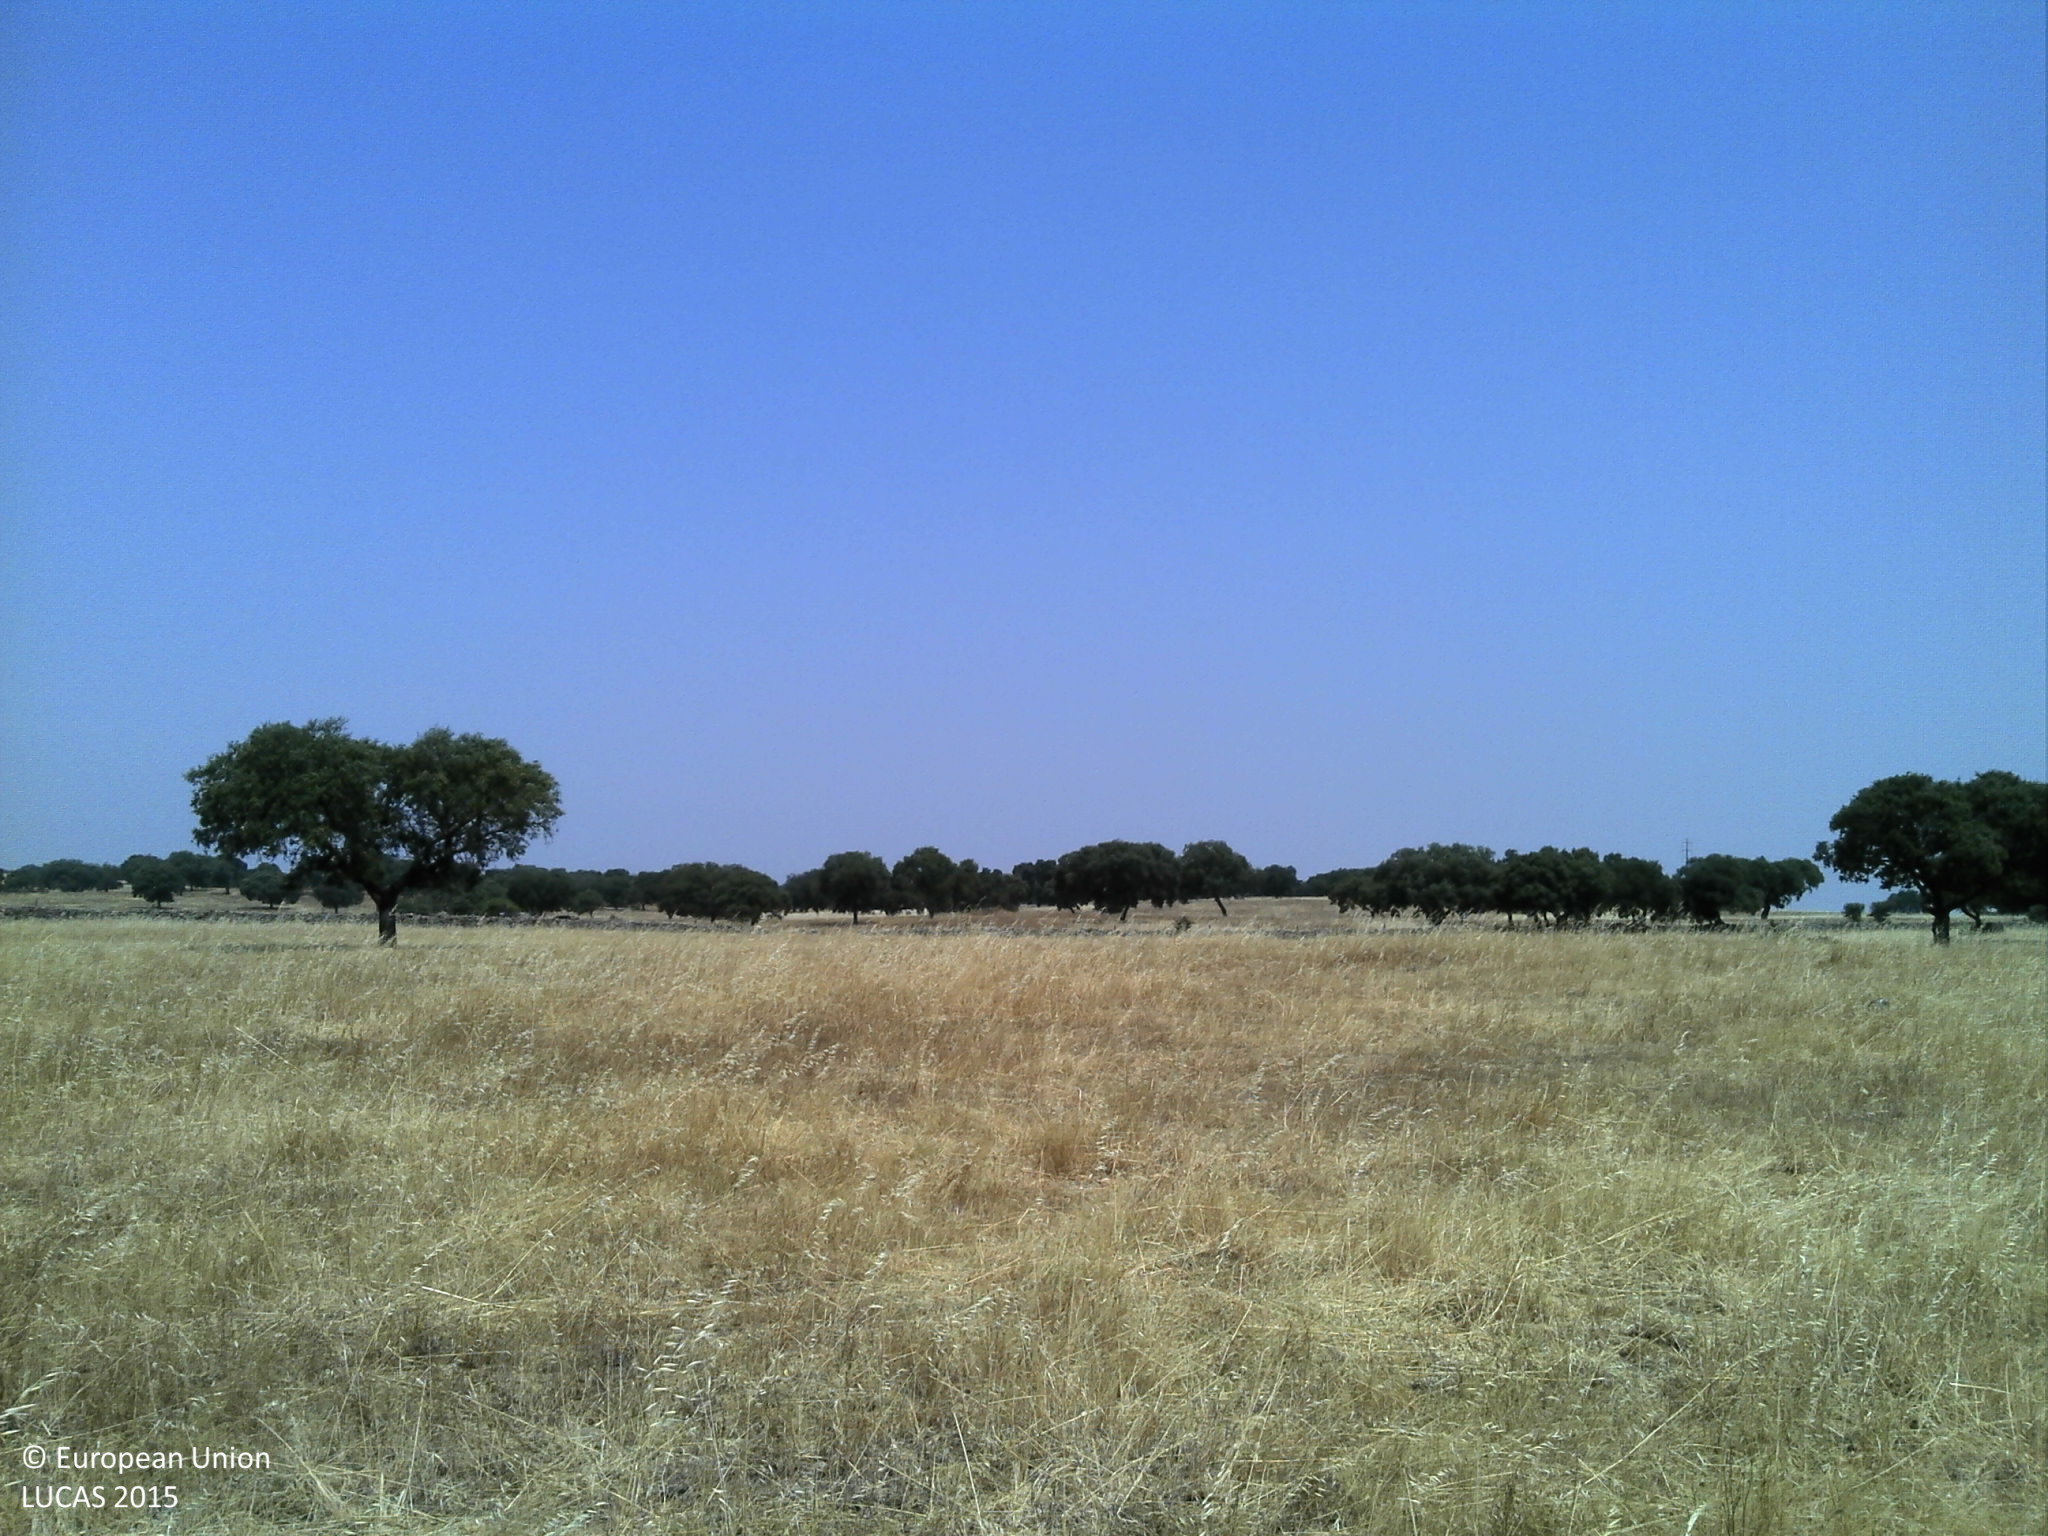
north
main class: Grassland
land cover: Grassland without tree/shrub cover
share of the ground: 50 - 75 %
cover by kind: herbaceous plants 60 %, unconsolidated bare surface 40 %
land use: Agriculture (excluding fallow land and kitchen gardens)
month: June
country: PT
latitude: 38.4744
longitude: -7.8134
